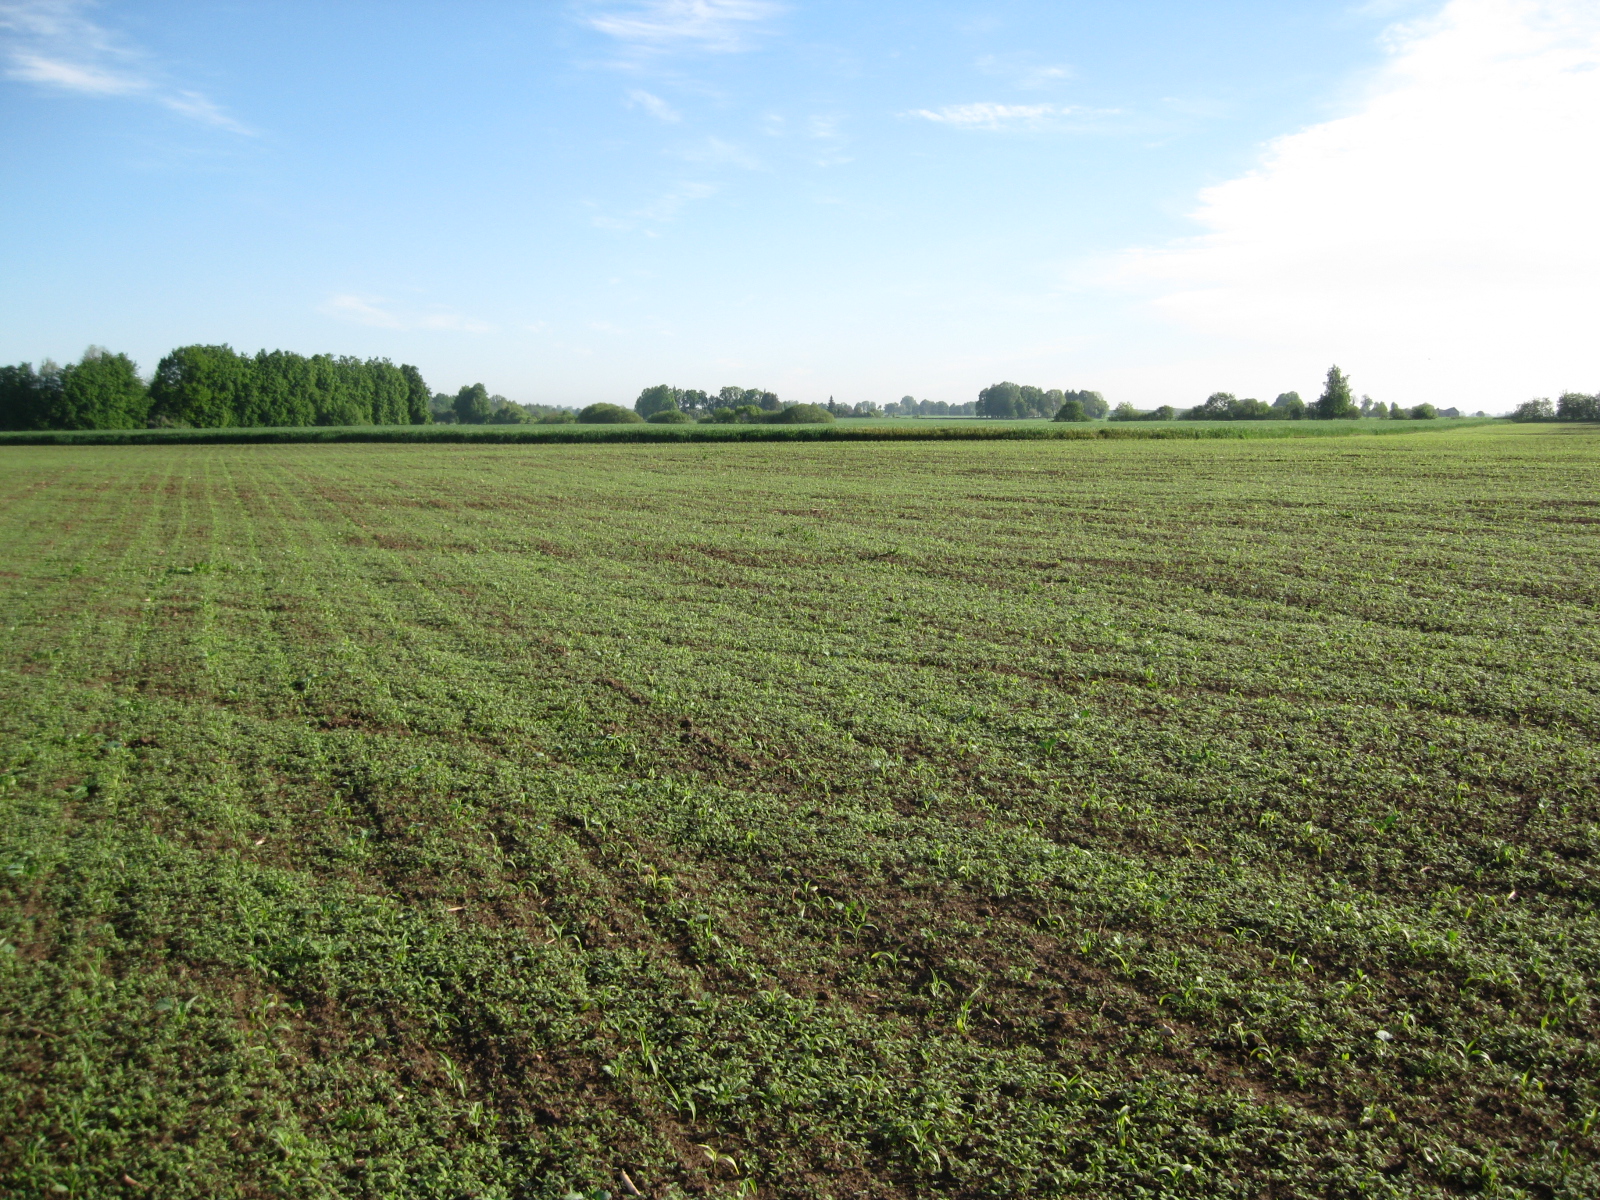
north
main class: Cropland
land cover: Maize
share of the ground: 25 - 50 %
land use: Agriculture (excluding fallow land and kitchen gardens)
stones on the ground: < 10 %
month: May
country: LT
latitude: 56.1659
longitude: 24.4777
